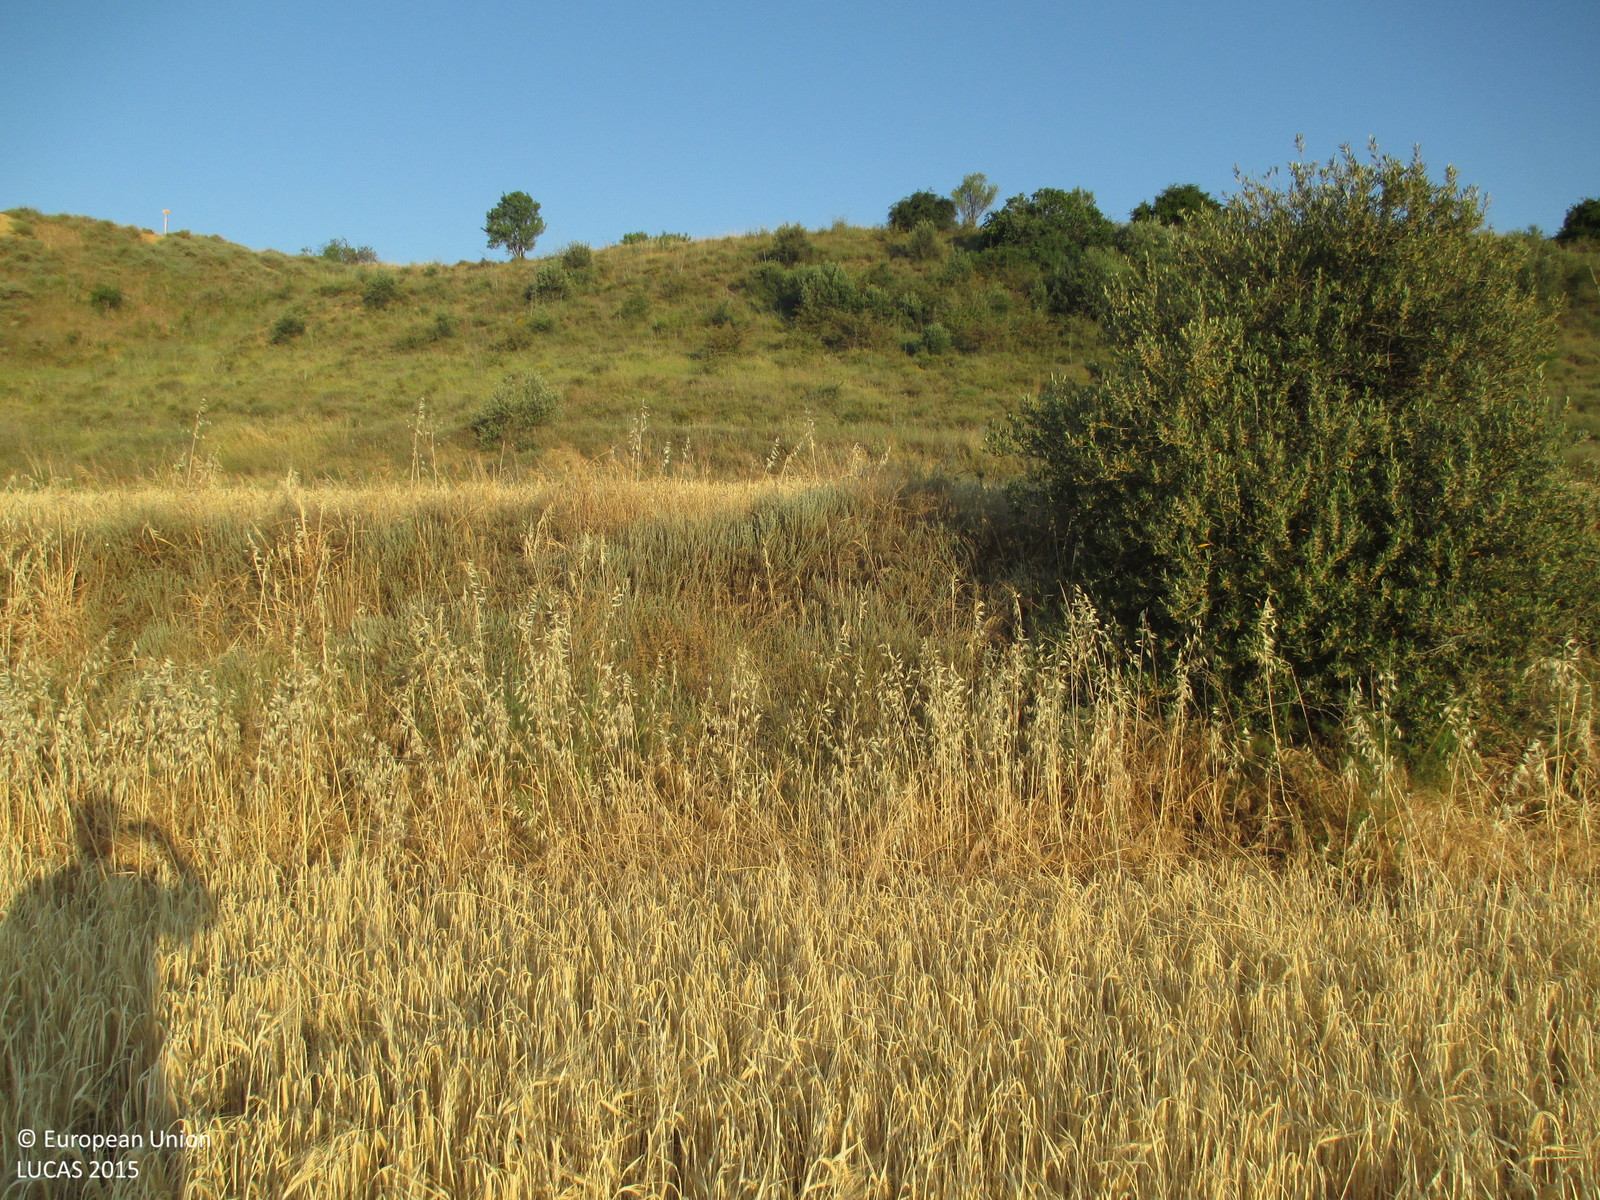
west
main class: Cropland
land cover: Barley
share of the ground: > 75 %
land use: Agriculture (excluding fallow land and kitchen gardens)
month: June
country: ES
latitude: 42.1542
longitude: -0.3941
